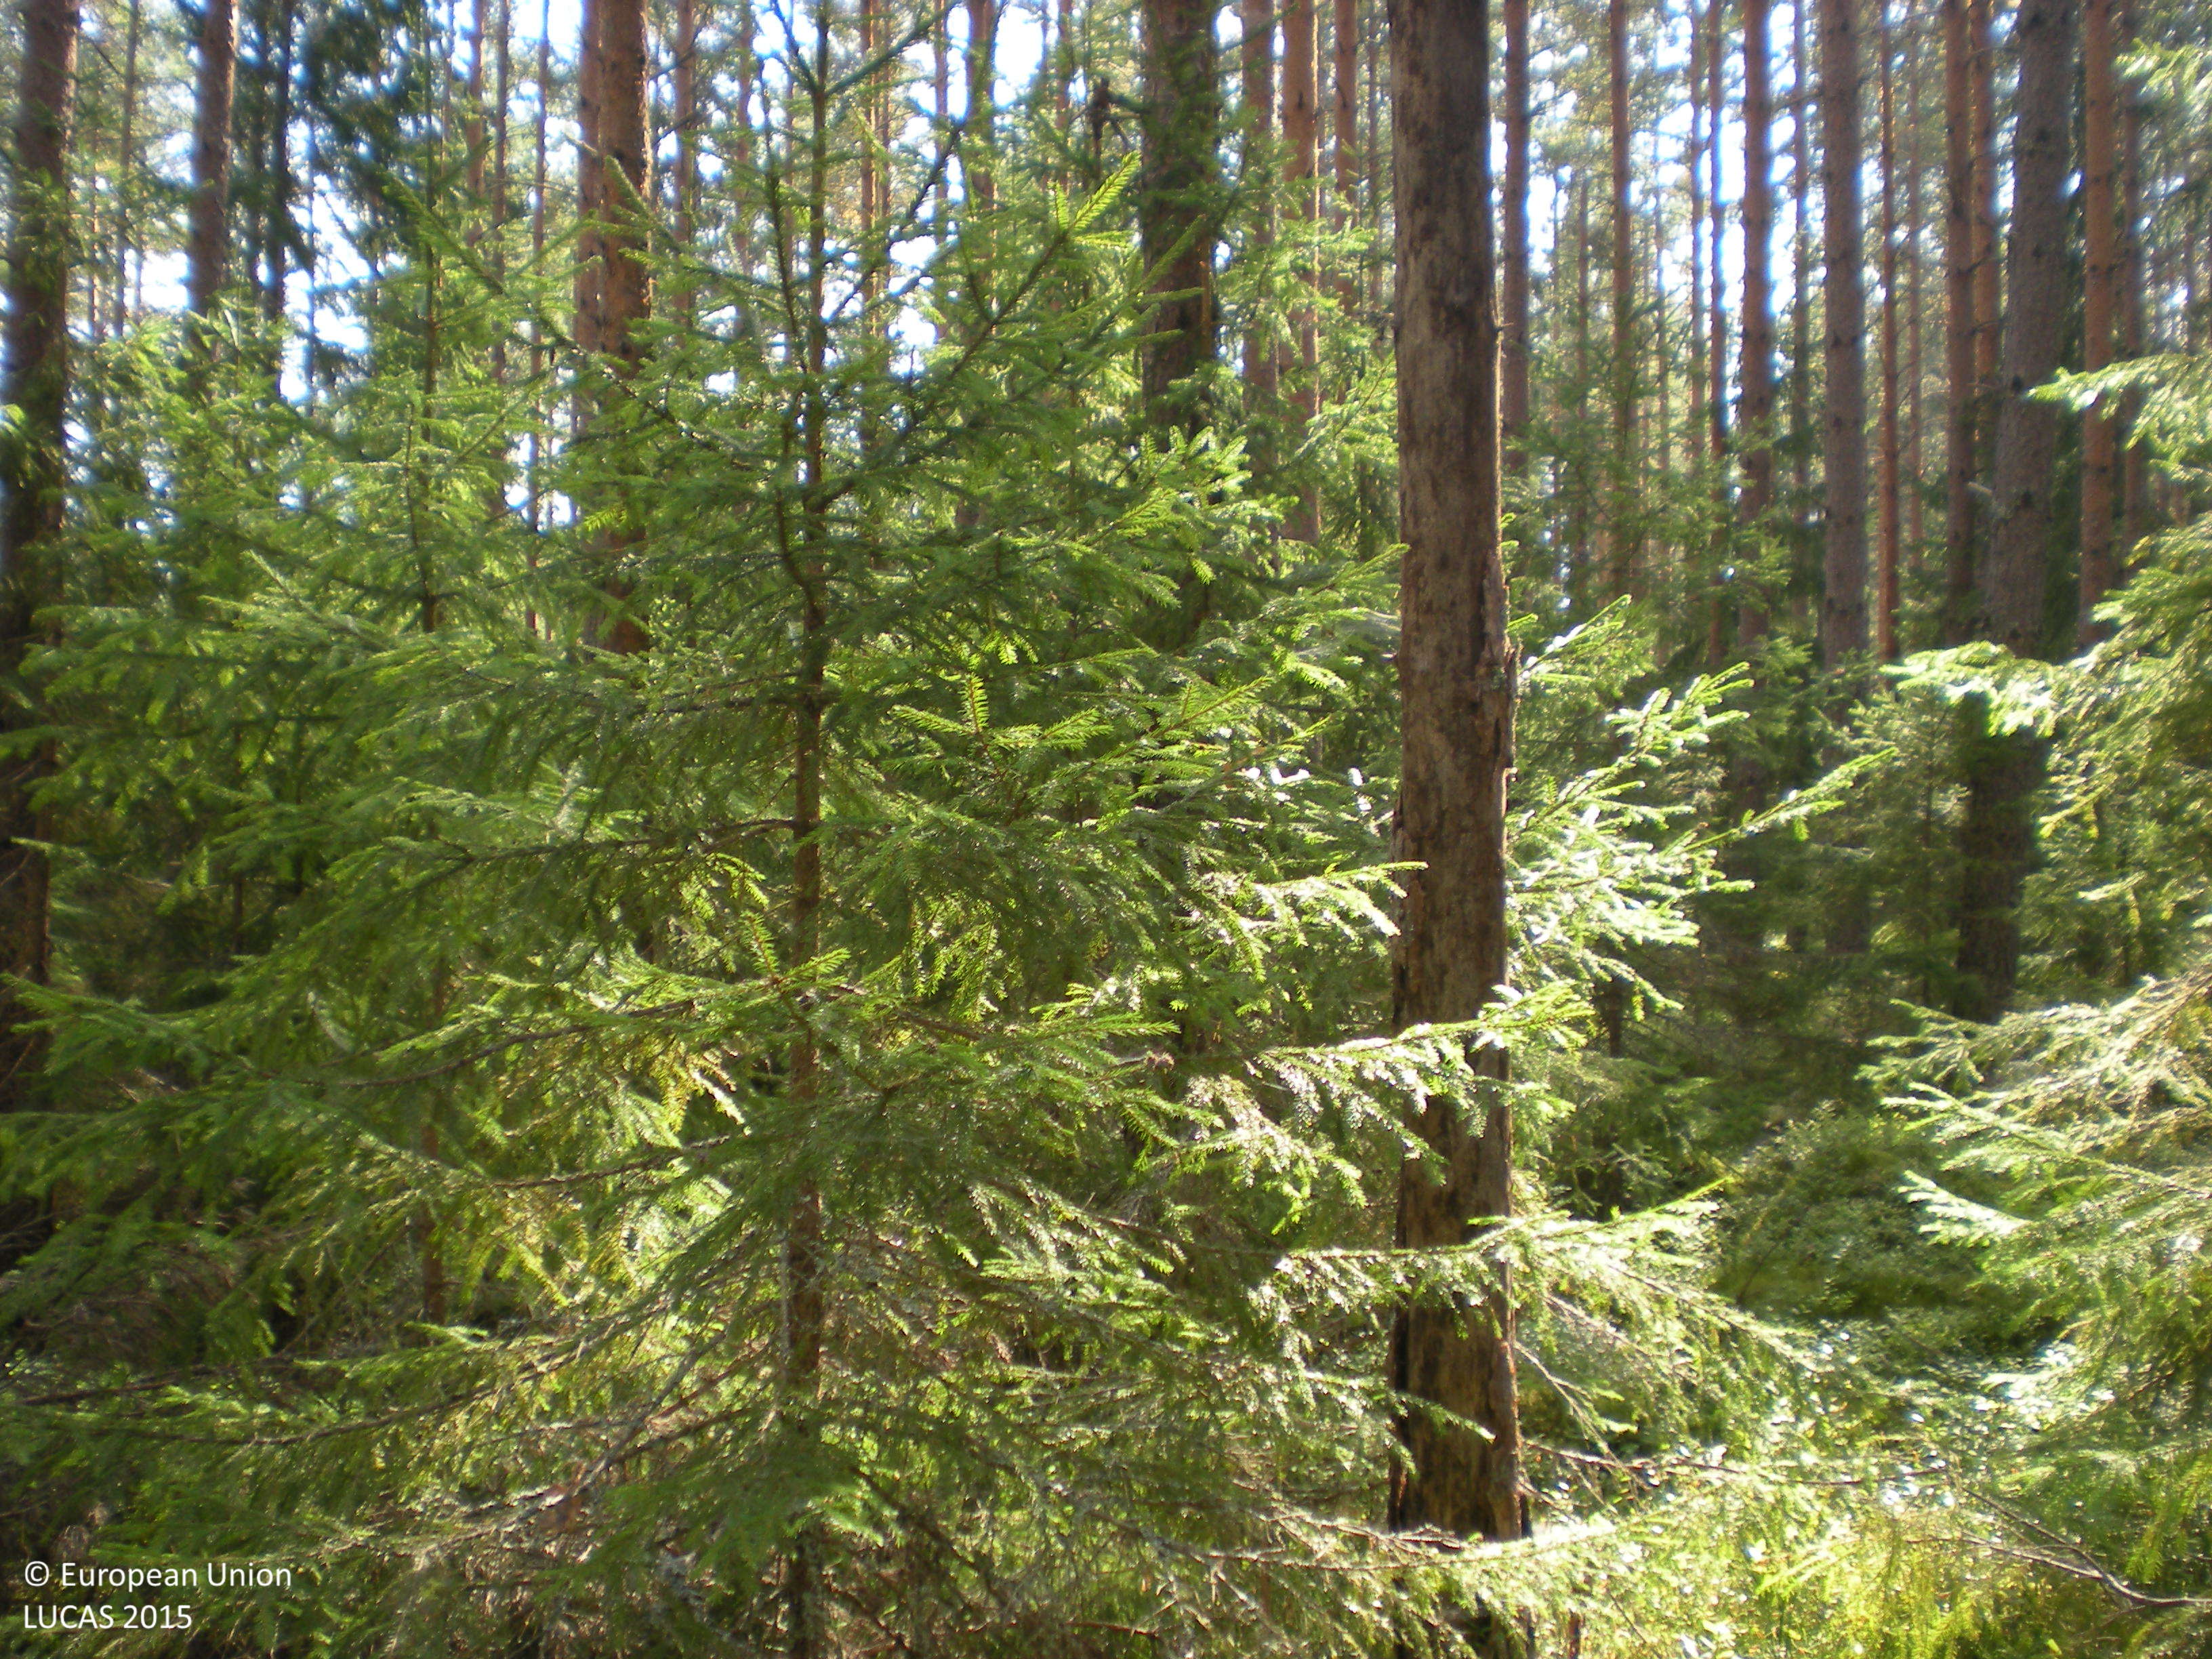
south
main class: Woodland
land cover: Pine dominated coniferous woodland
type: boreal forest
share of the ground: 50 - 75 %
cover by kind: coniferous forest trees 70 %, shrubs 25 %, lichens and mosses 5 %
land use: Forestry
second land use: Amenities, museums, leisure
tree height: > 5 m
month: August
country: SE
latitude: 60.4164
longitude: 17.1266
